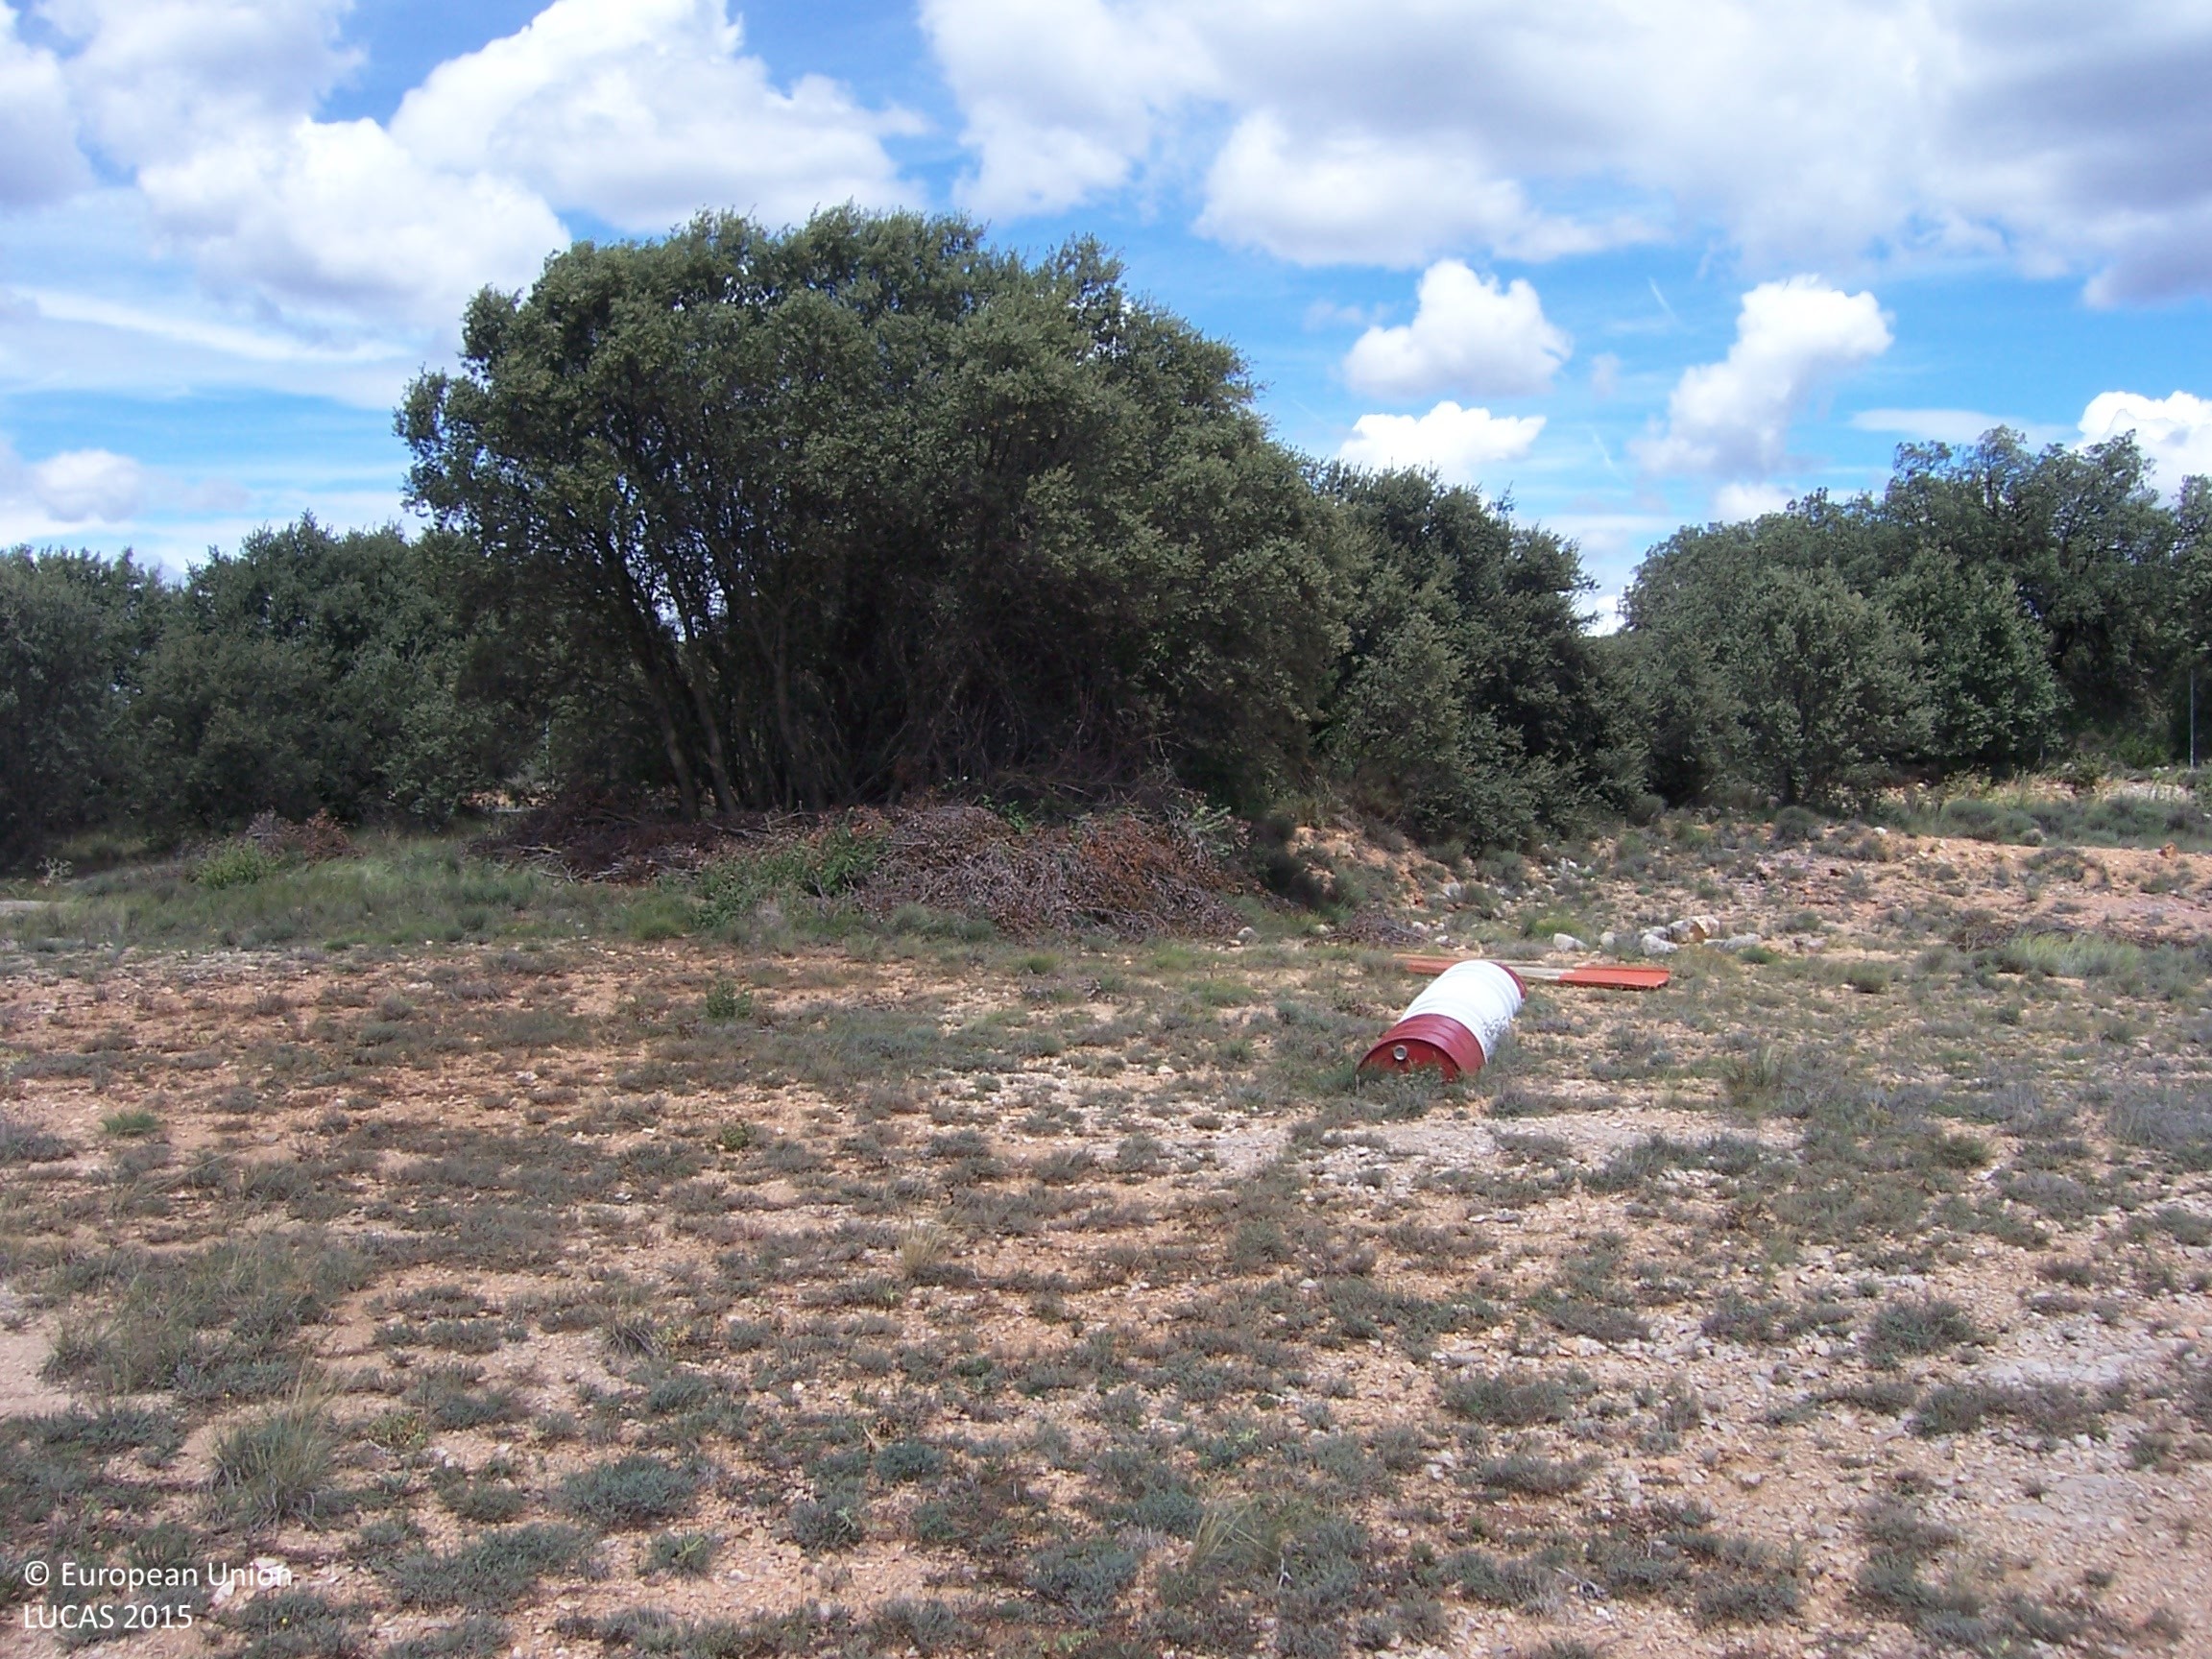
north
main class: Grassland
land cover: Grassland without tree/shrub cover
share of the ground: > 75 %
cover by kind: herbaceous plants 80 %, unconsolidated bare surface 20 %
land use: Air transport
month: August
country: ES
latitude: 42.0228
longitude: 0.4791
